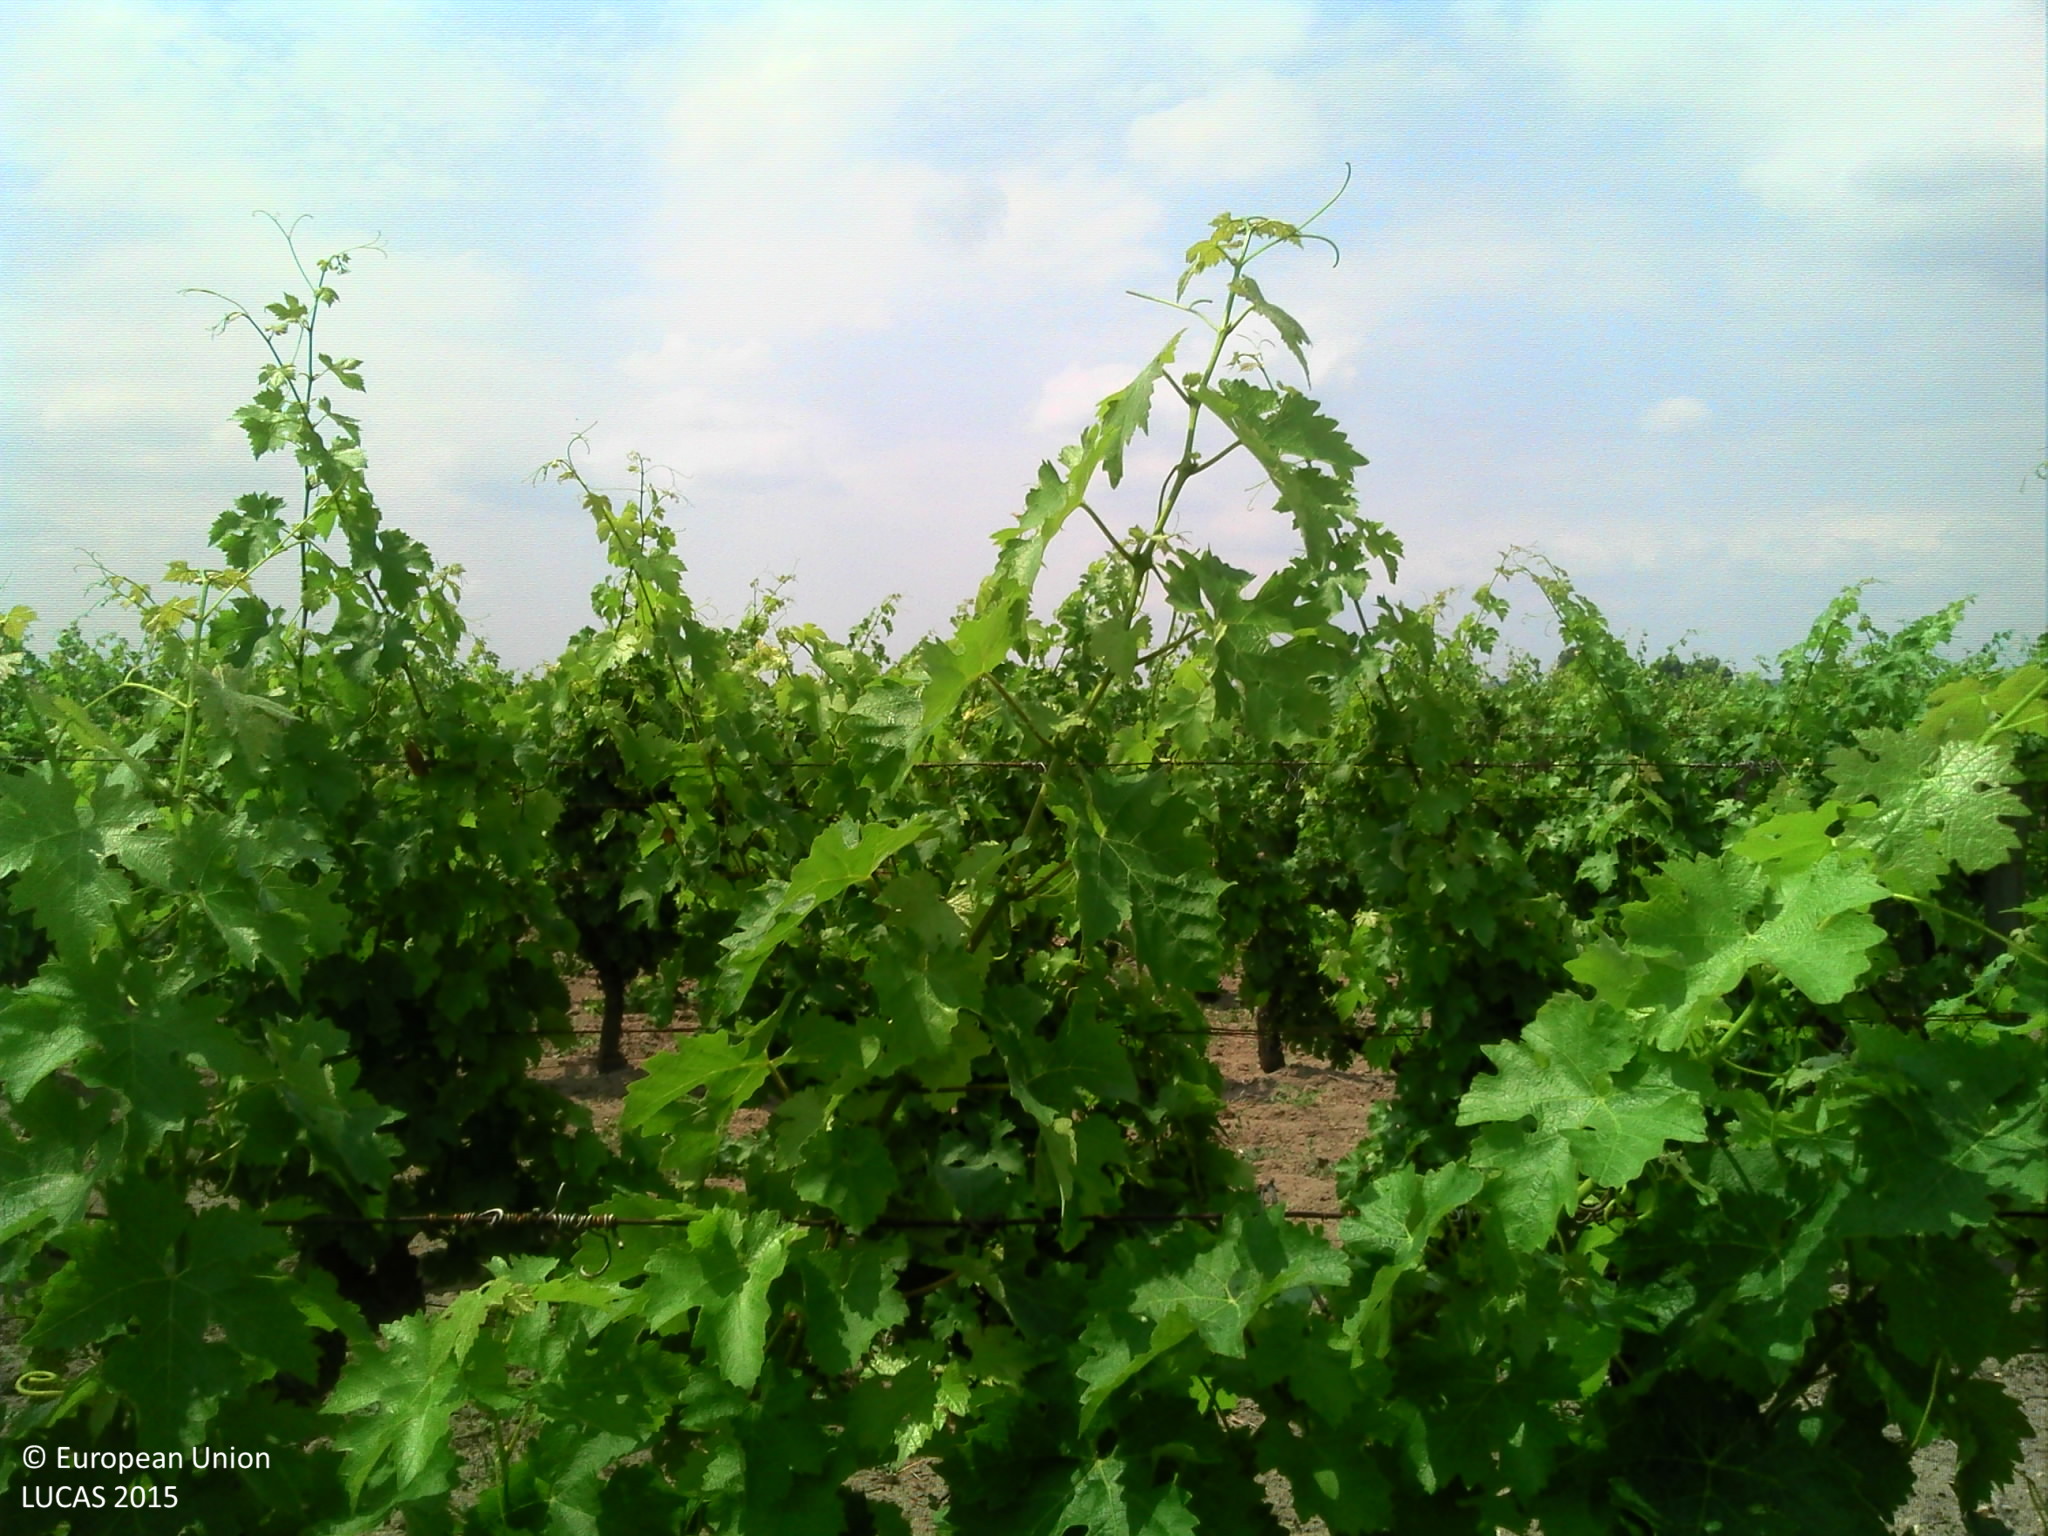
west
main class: Cropland
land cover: Vineyards
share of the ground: 25 - 50 %
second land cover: Other bare soil
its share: > 75 %
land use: Agriculture (excluding fallow land and kitchen gardens)
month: July
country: FR
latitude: 47.2897
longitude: 0.1252
